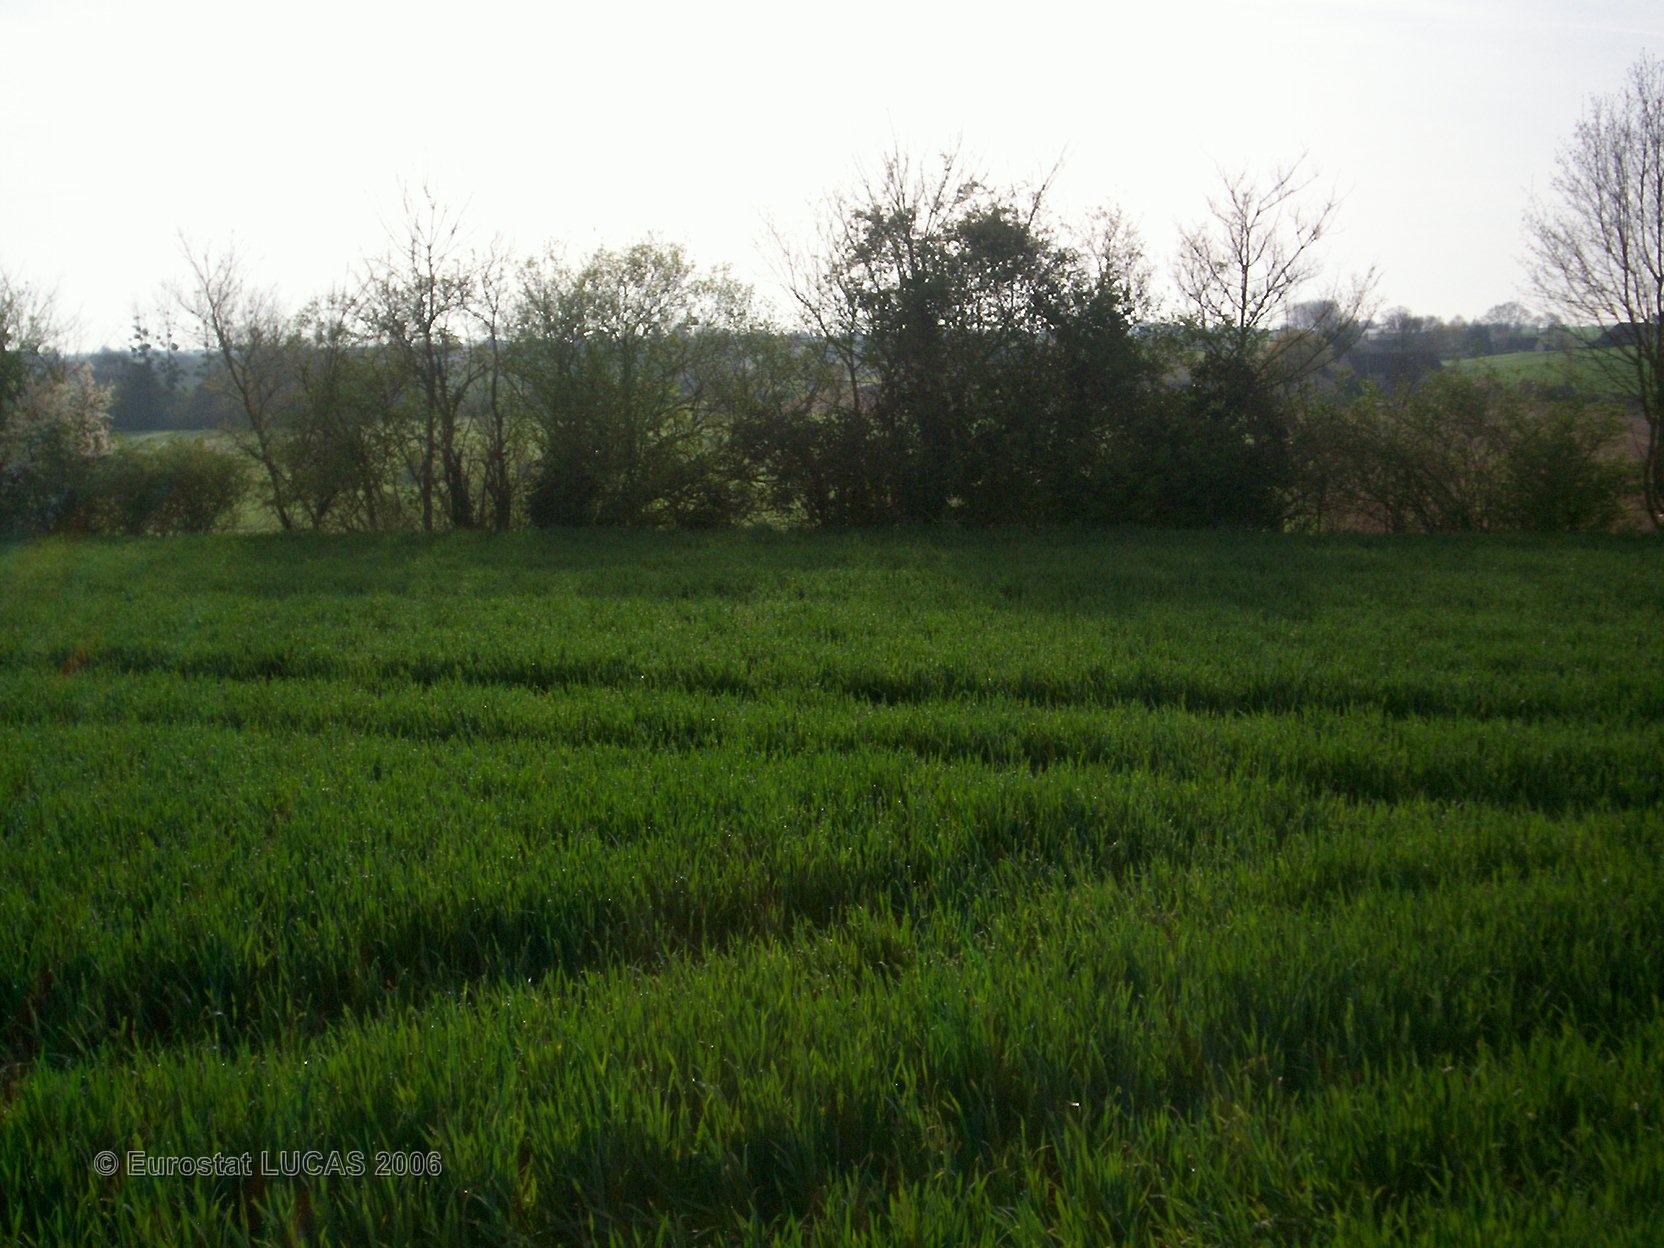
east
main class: Cropland
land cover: Common wheat
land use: Agriculture (excluding fallow land and kitchen gardens)
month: April
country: FR
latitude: 48.2685
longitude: 0.1239
